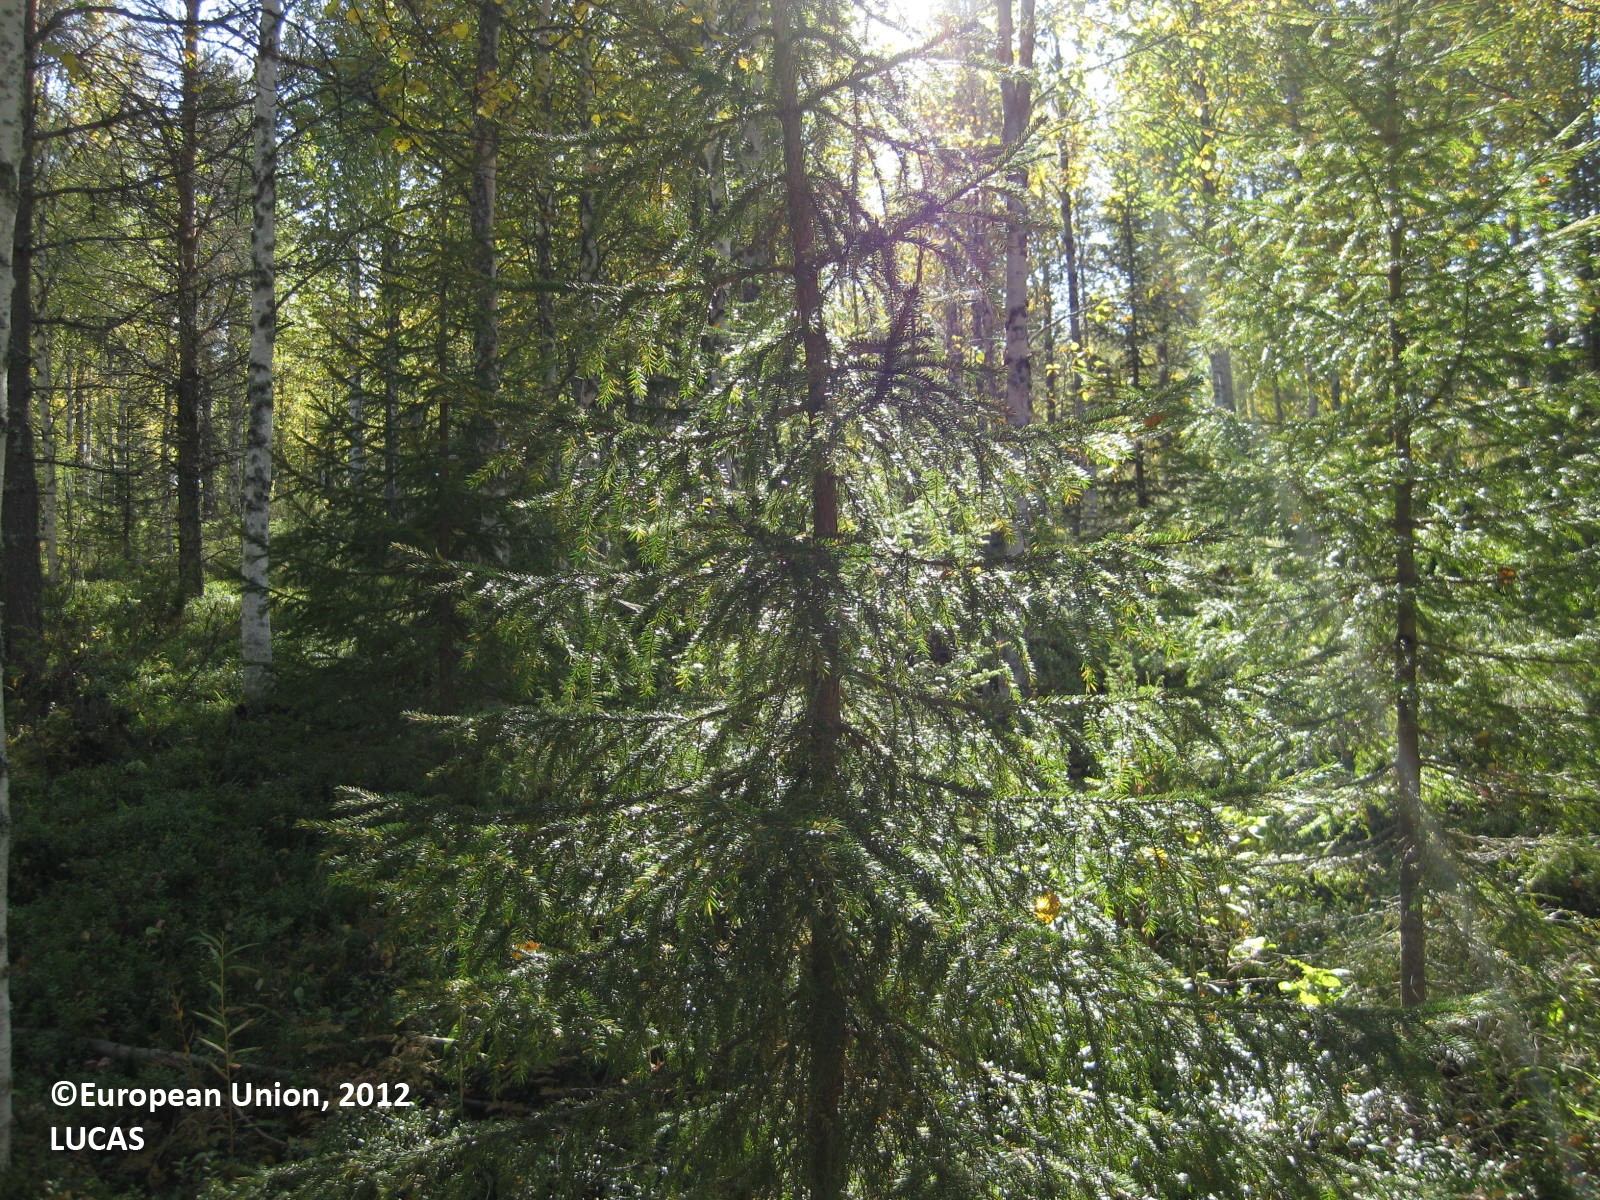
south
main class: Woodland
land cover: Broadleaved woodland
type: boreal forest
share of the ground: 50 - 75 %
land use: Forestry
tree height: > 5 m
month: August
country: FI
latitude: 65.8419
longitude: 28.6204
